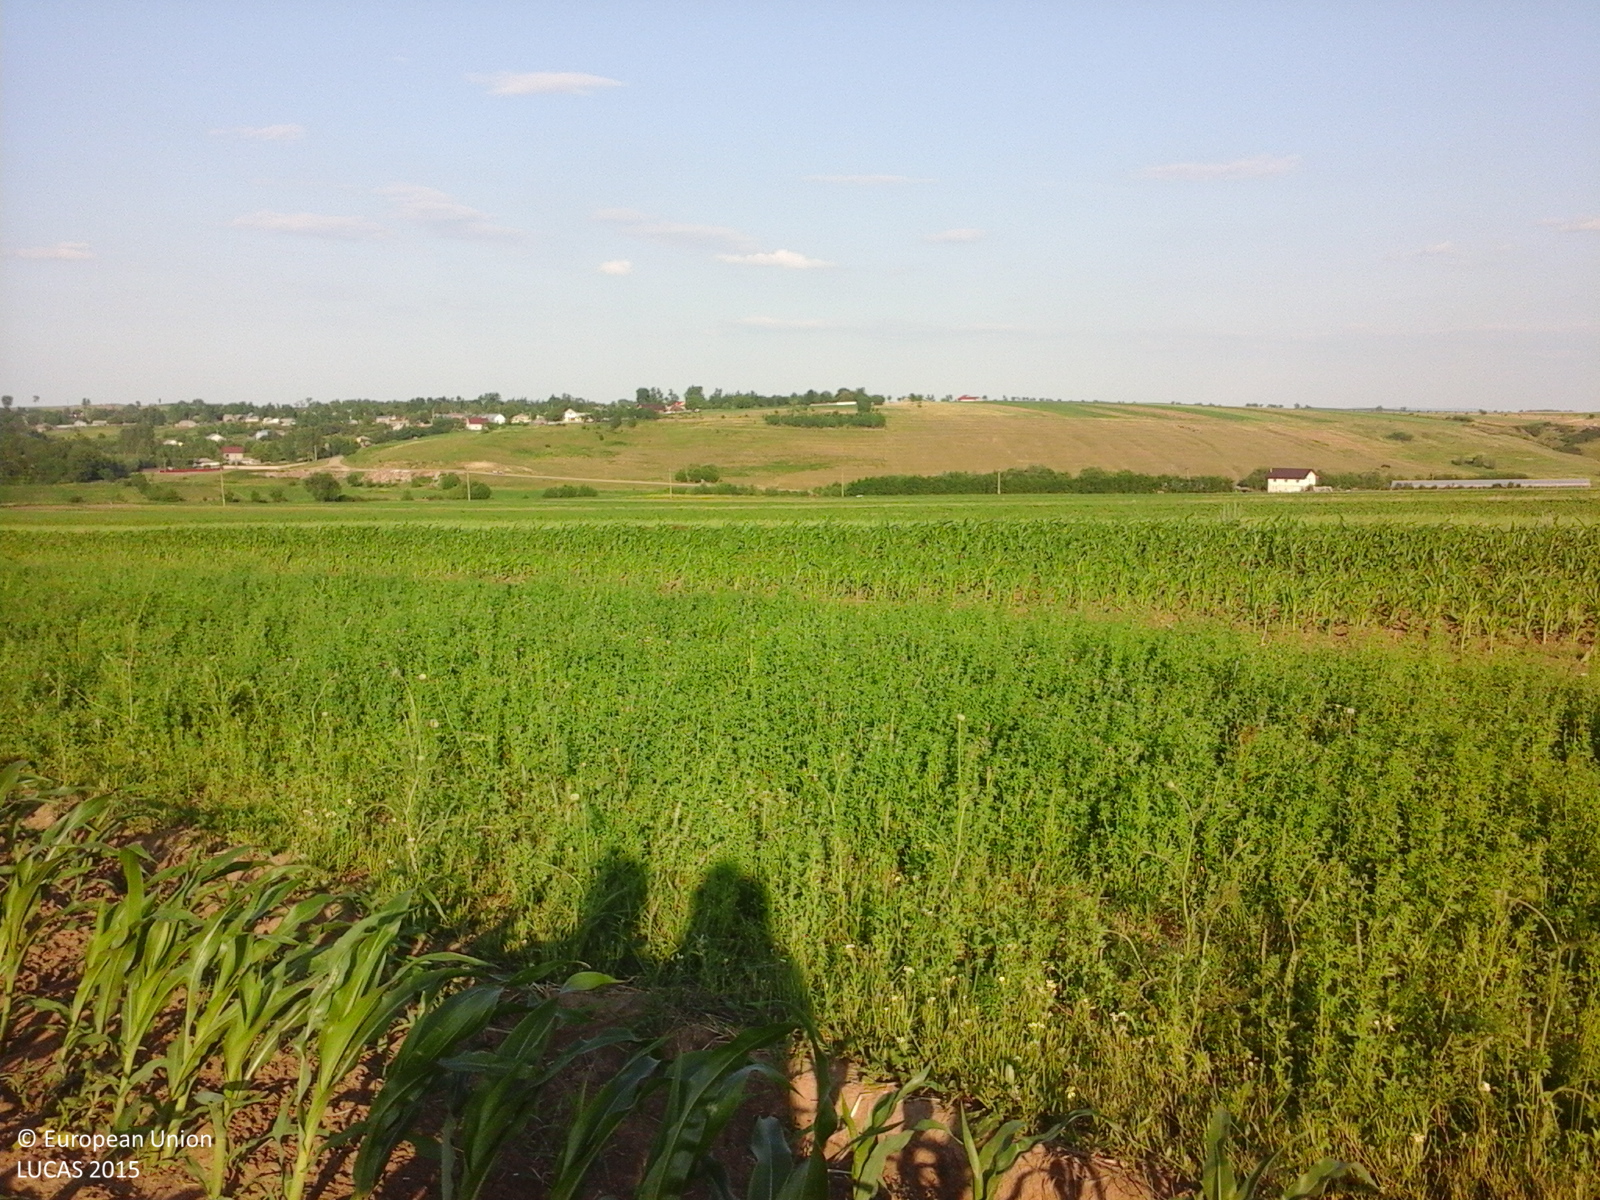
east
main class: Cropland
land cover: Maize
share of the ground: 25 - 50 %
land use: Agriculture (excluding fallow land and kitchen gardens)
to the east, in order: Maize; Lucerne; Maize; Lucerne; Common wheat; Maize; Other bare soil; Sunflower
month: June
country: RO
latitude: 47.7000
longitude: 26.5215
